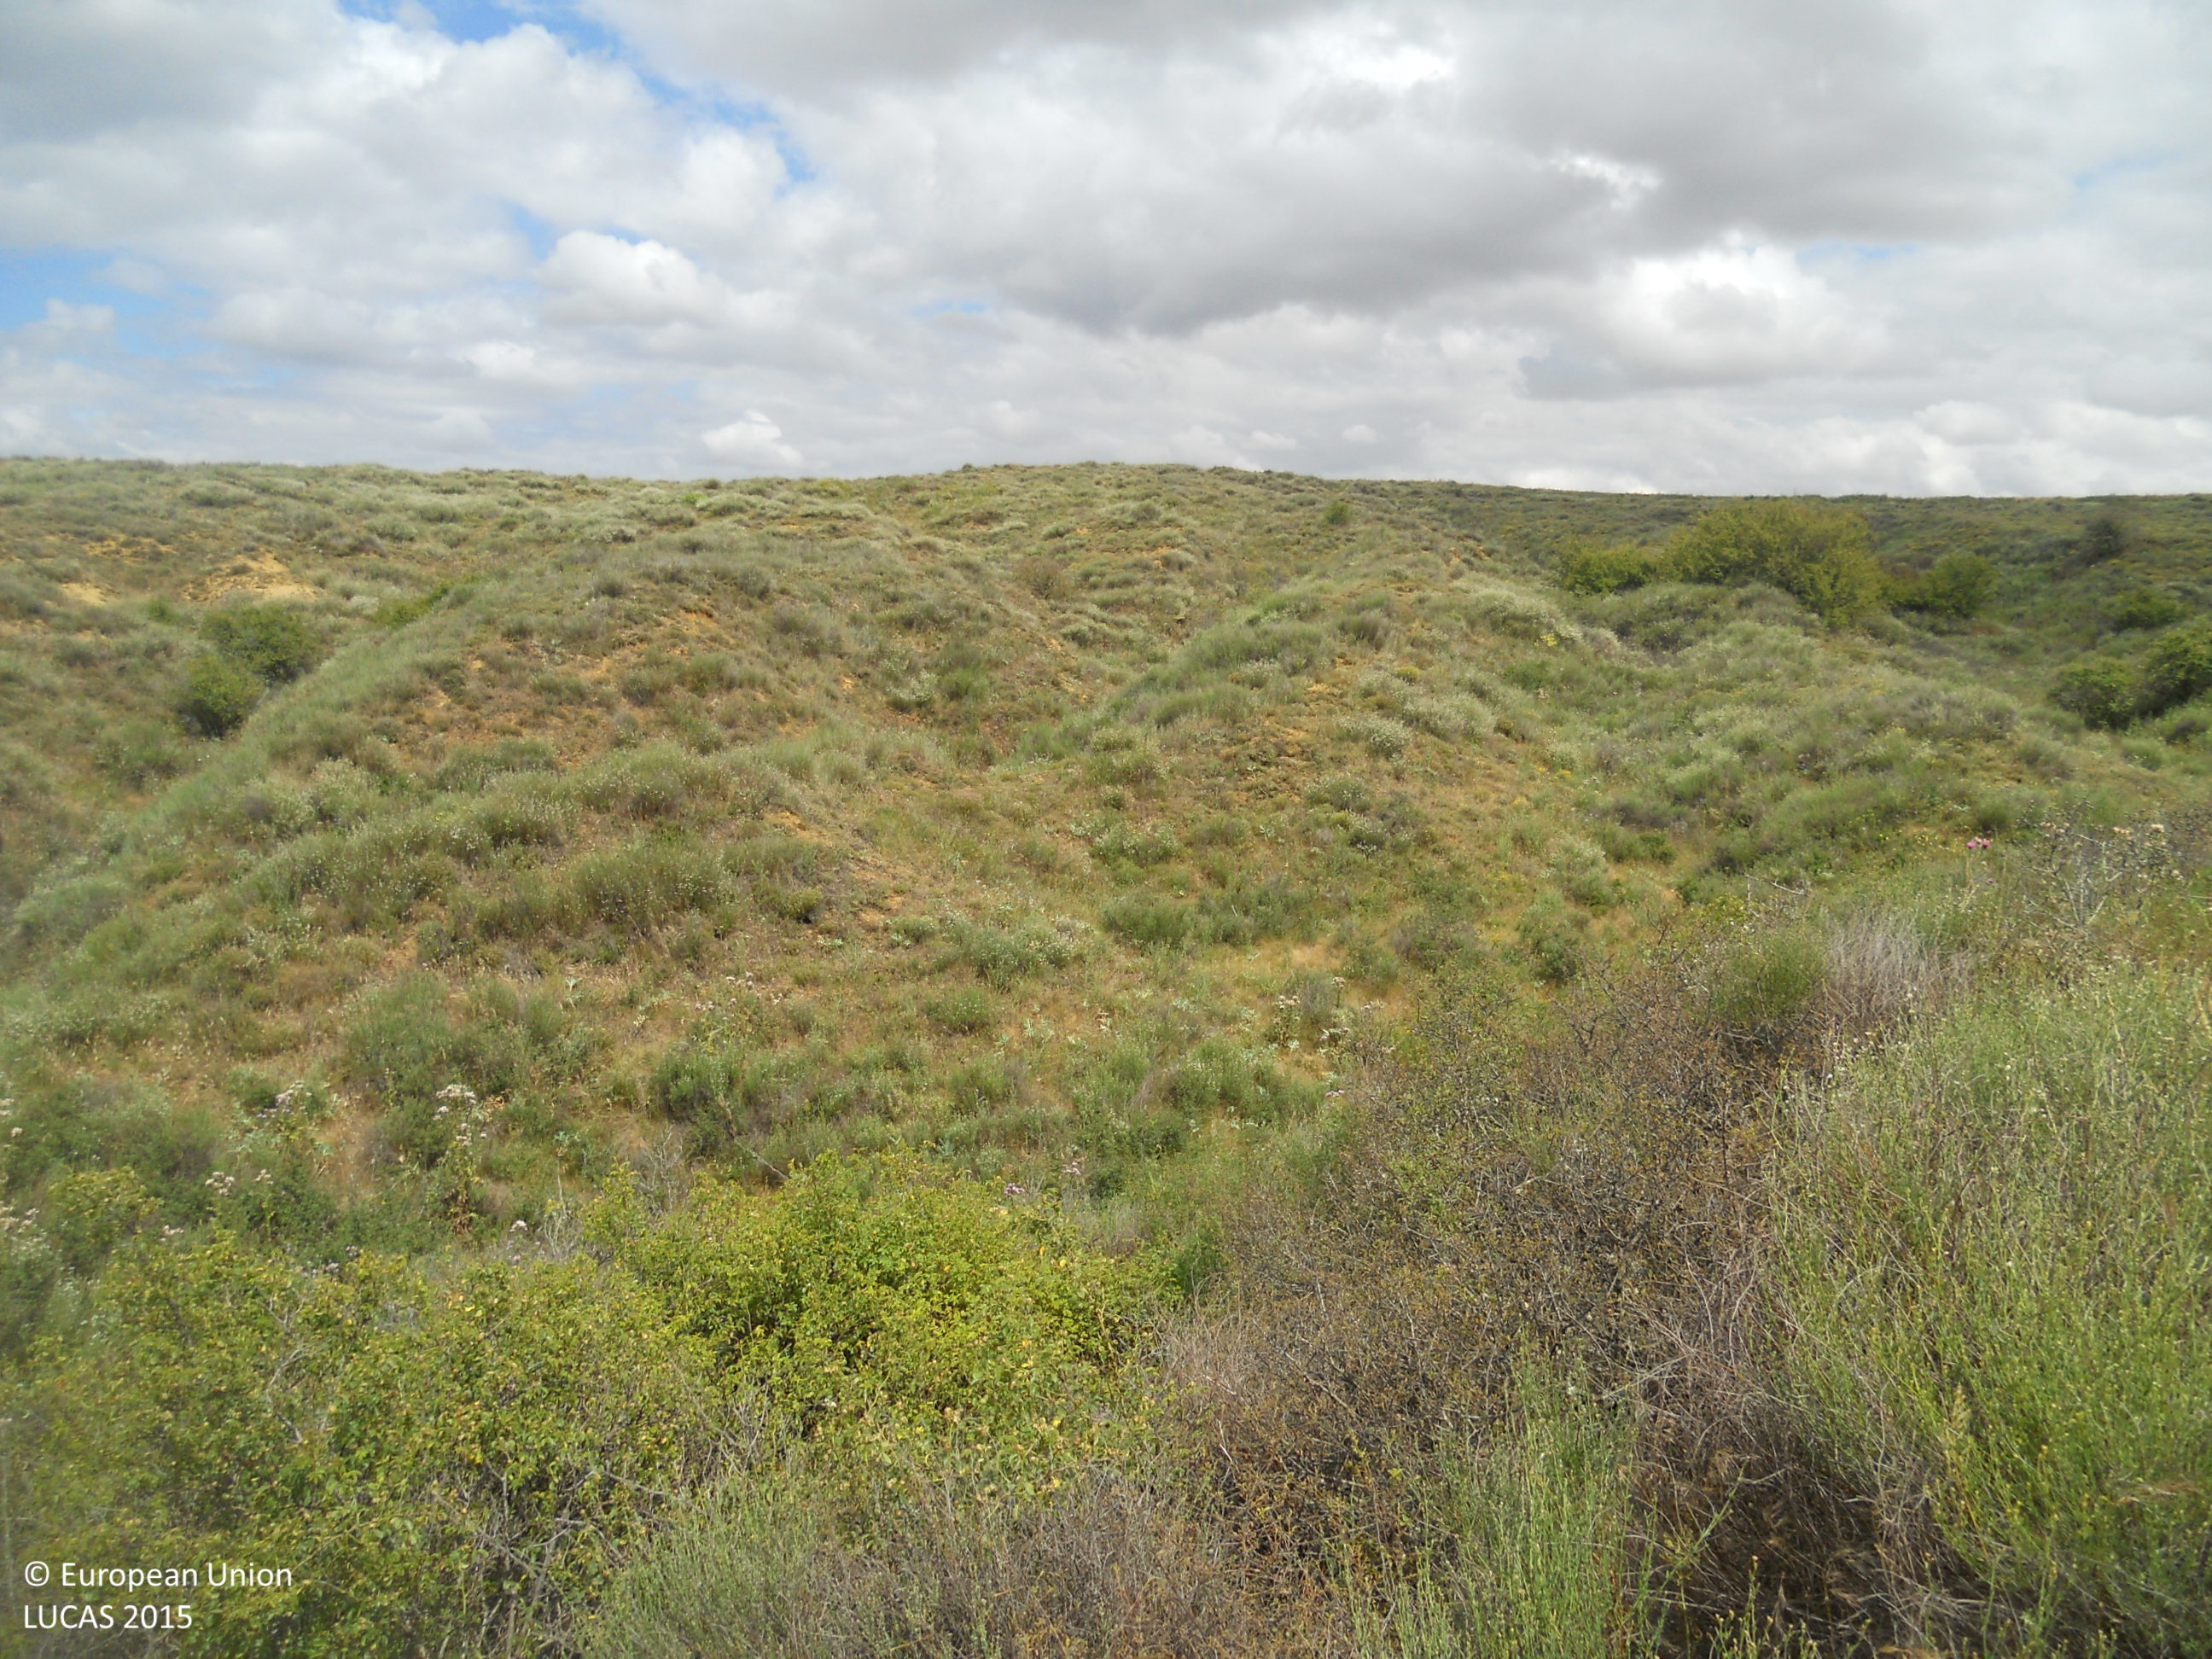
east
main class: Shrubland
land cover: Shrubland without tree cover
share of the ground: > 75 %
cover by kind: shrubs 95 %, herbaceous plants 5 %
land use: Semi-natural and natural areas not in use
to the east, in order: Shrubland without tree cover; Tracks; Shrubland without tree cover; Mixed cereals for fodder
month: June
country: ES
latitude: 42.3261
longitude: -4.9468
